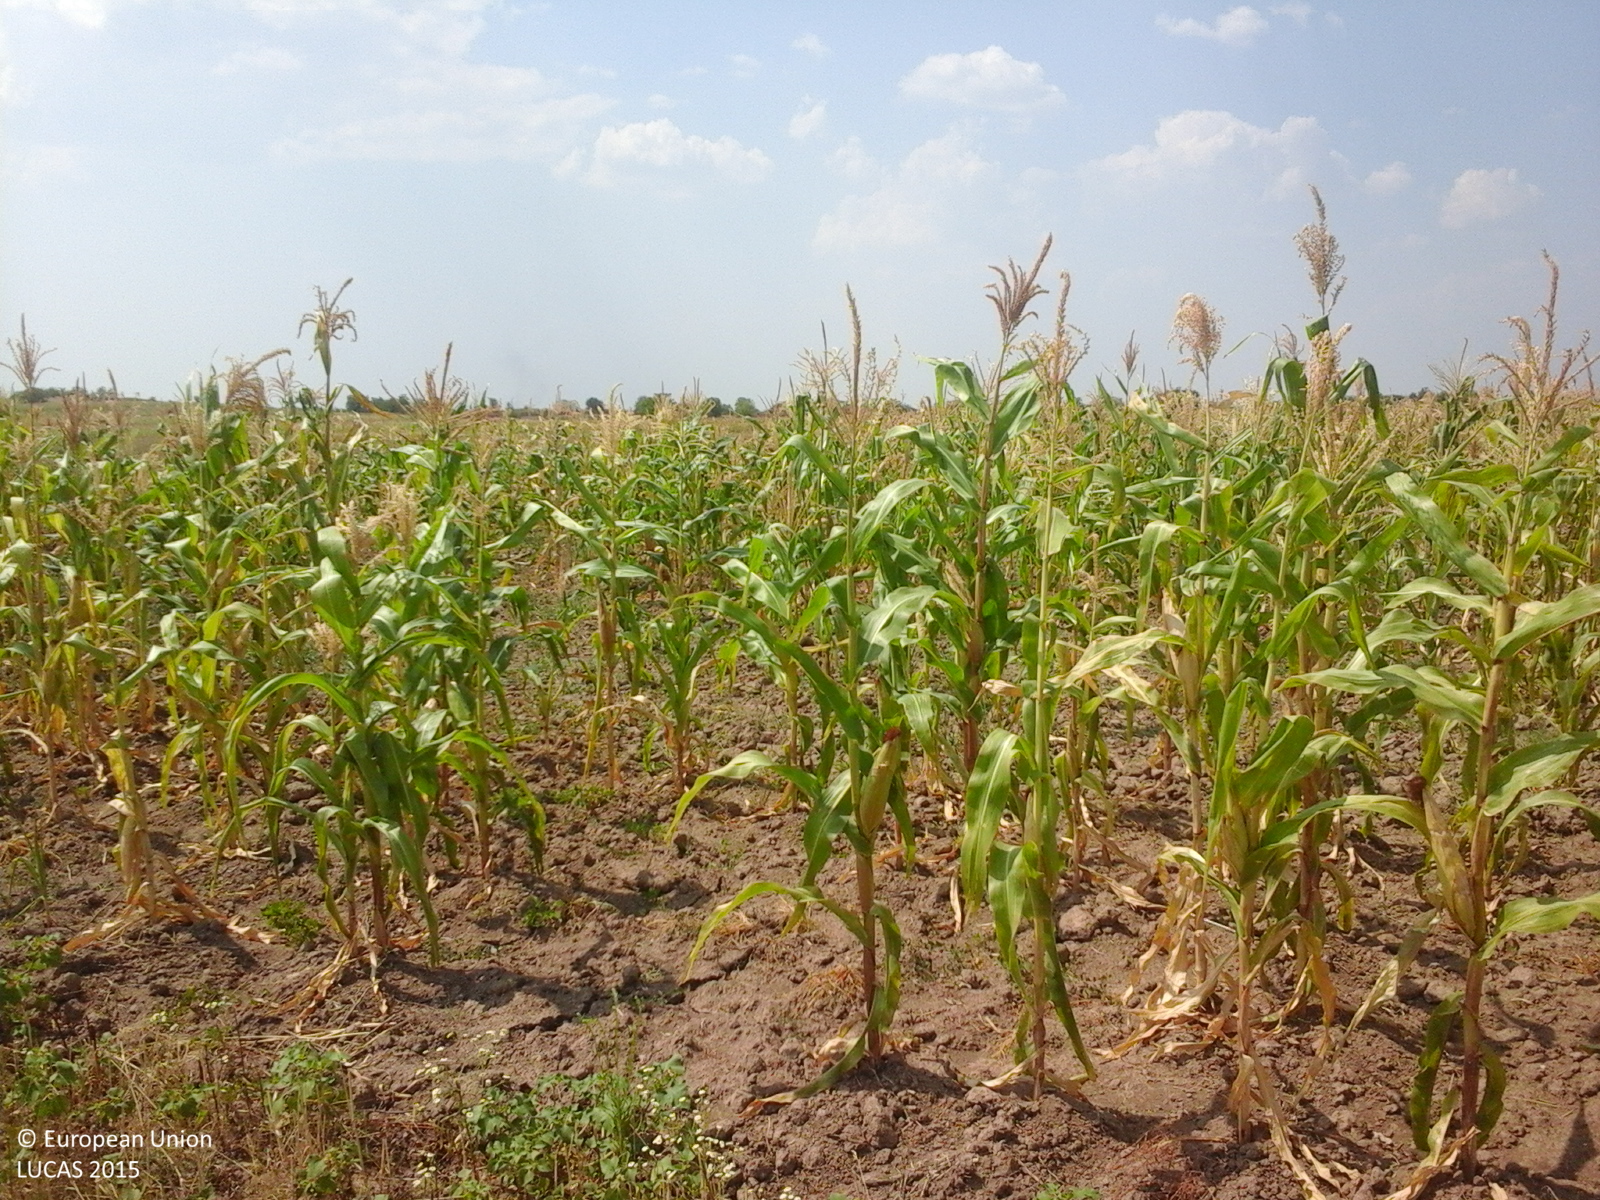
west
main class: Cropland
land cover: Common wheat
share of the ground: > 75 %
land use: Agriculture (excluding fallow land and kitchen gardens)
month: August
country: RO
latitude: 44.3840
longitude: 23.1640
